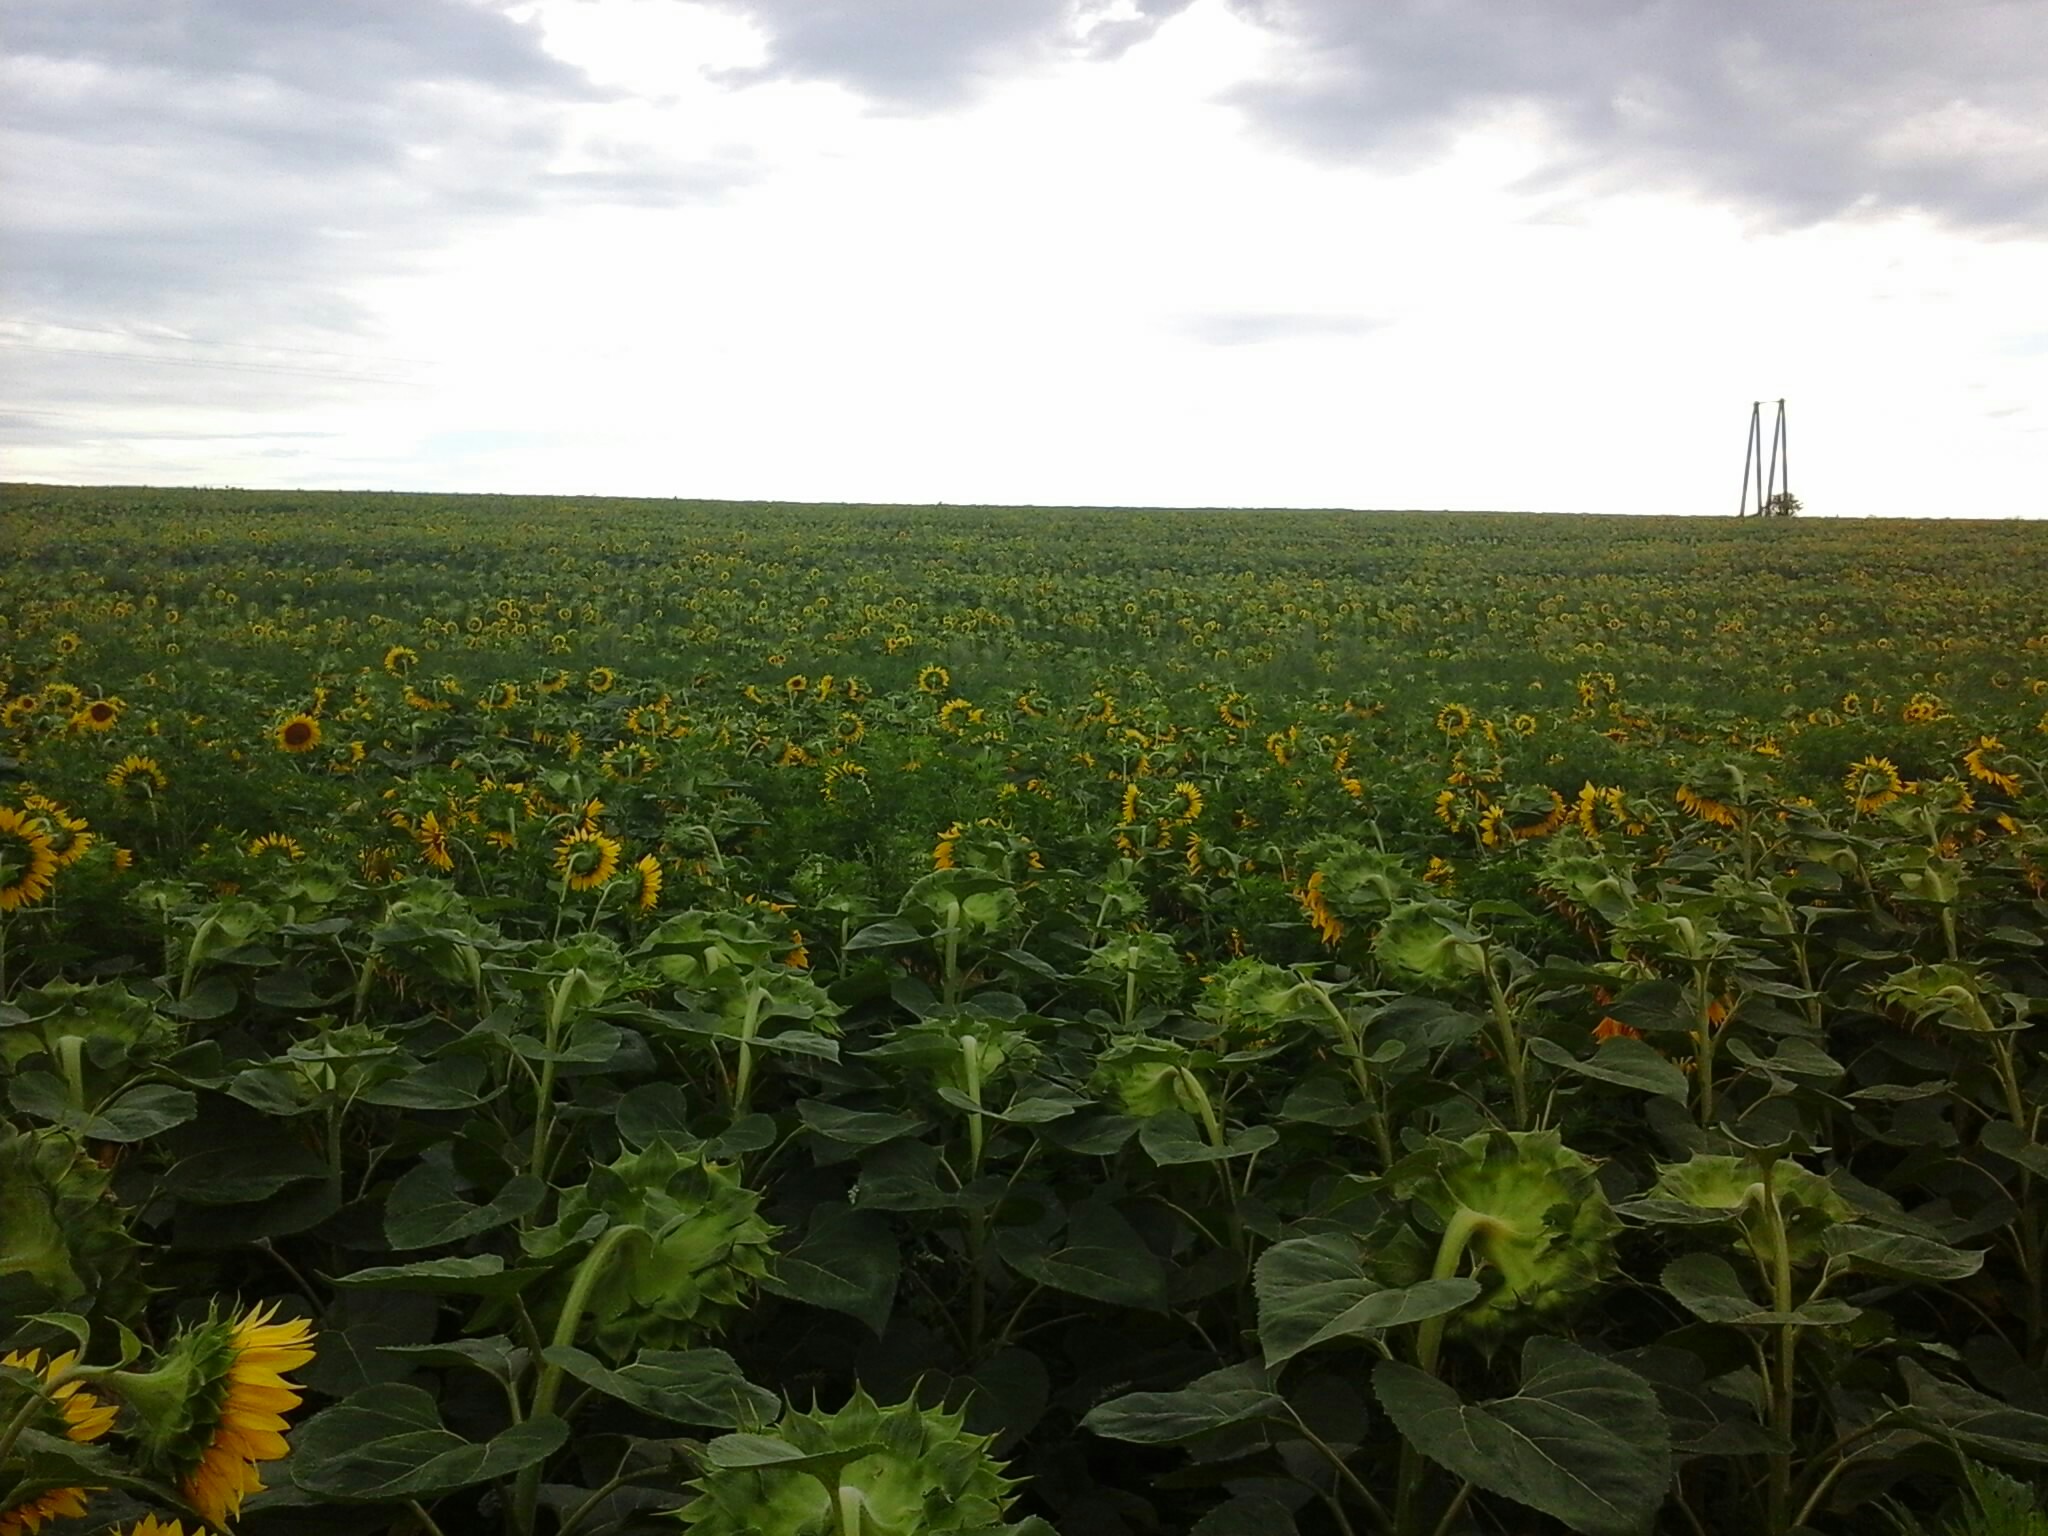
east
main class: Cropland
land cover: Sunflower
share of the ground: > 75 %
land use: Agriculture (excluding fallow land and kitchen gardens)
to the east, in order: Sunflower; Electric lines; Sunflower
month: July
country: HU
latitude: 48.4530
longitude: 21.1706
